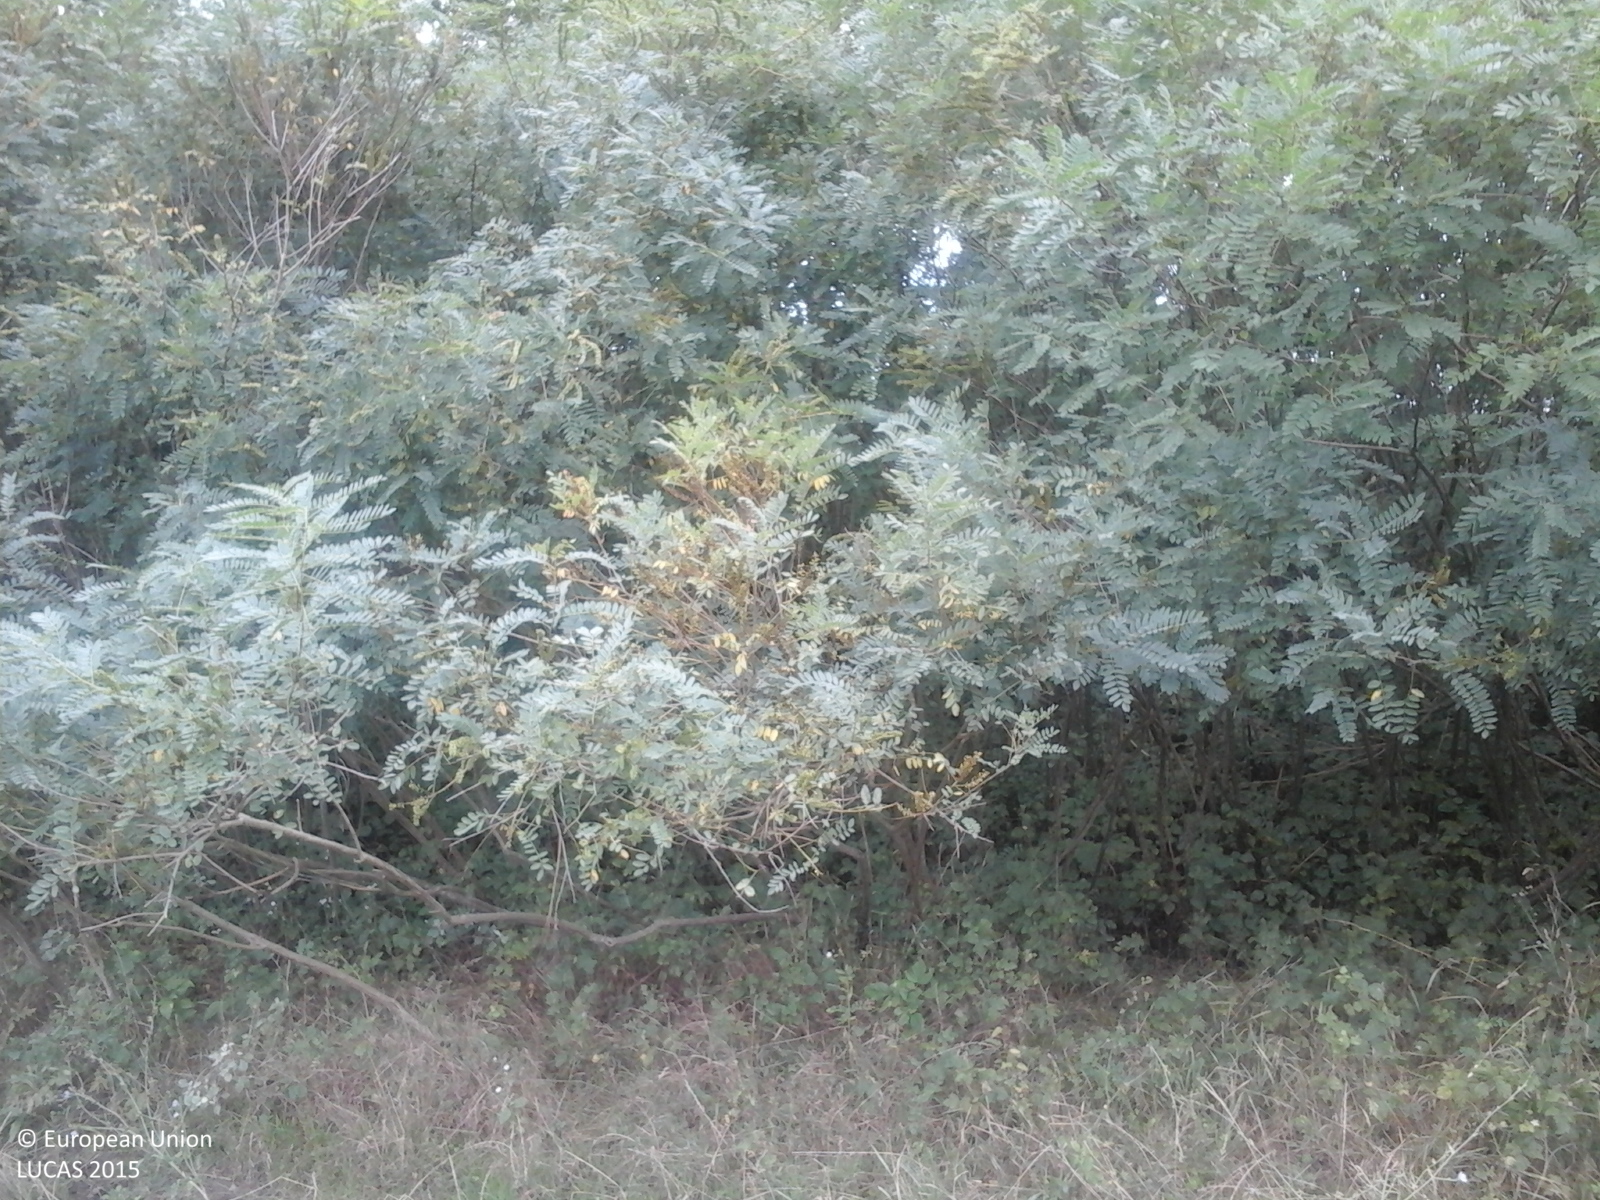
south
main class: Cropland
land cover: Lucerne
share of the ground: > 75 %
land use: Agriculture (excluding fallow land and kitchen gardens)
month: August
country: RO
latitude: 46.0925
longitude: 21.6654
